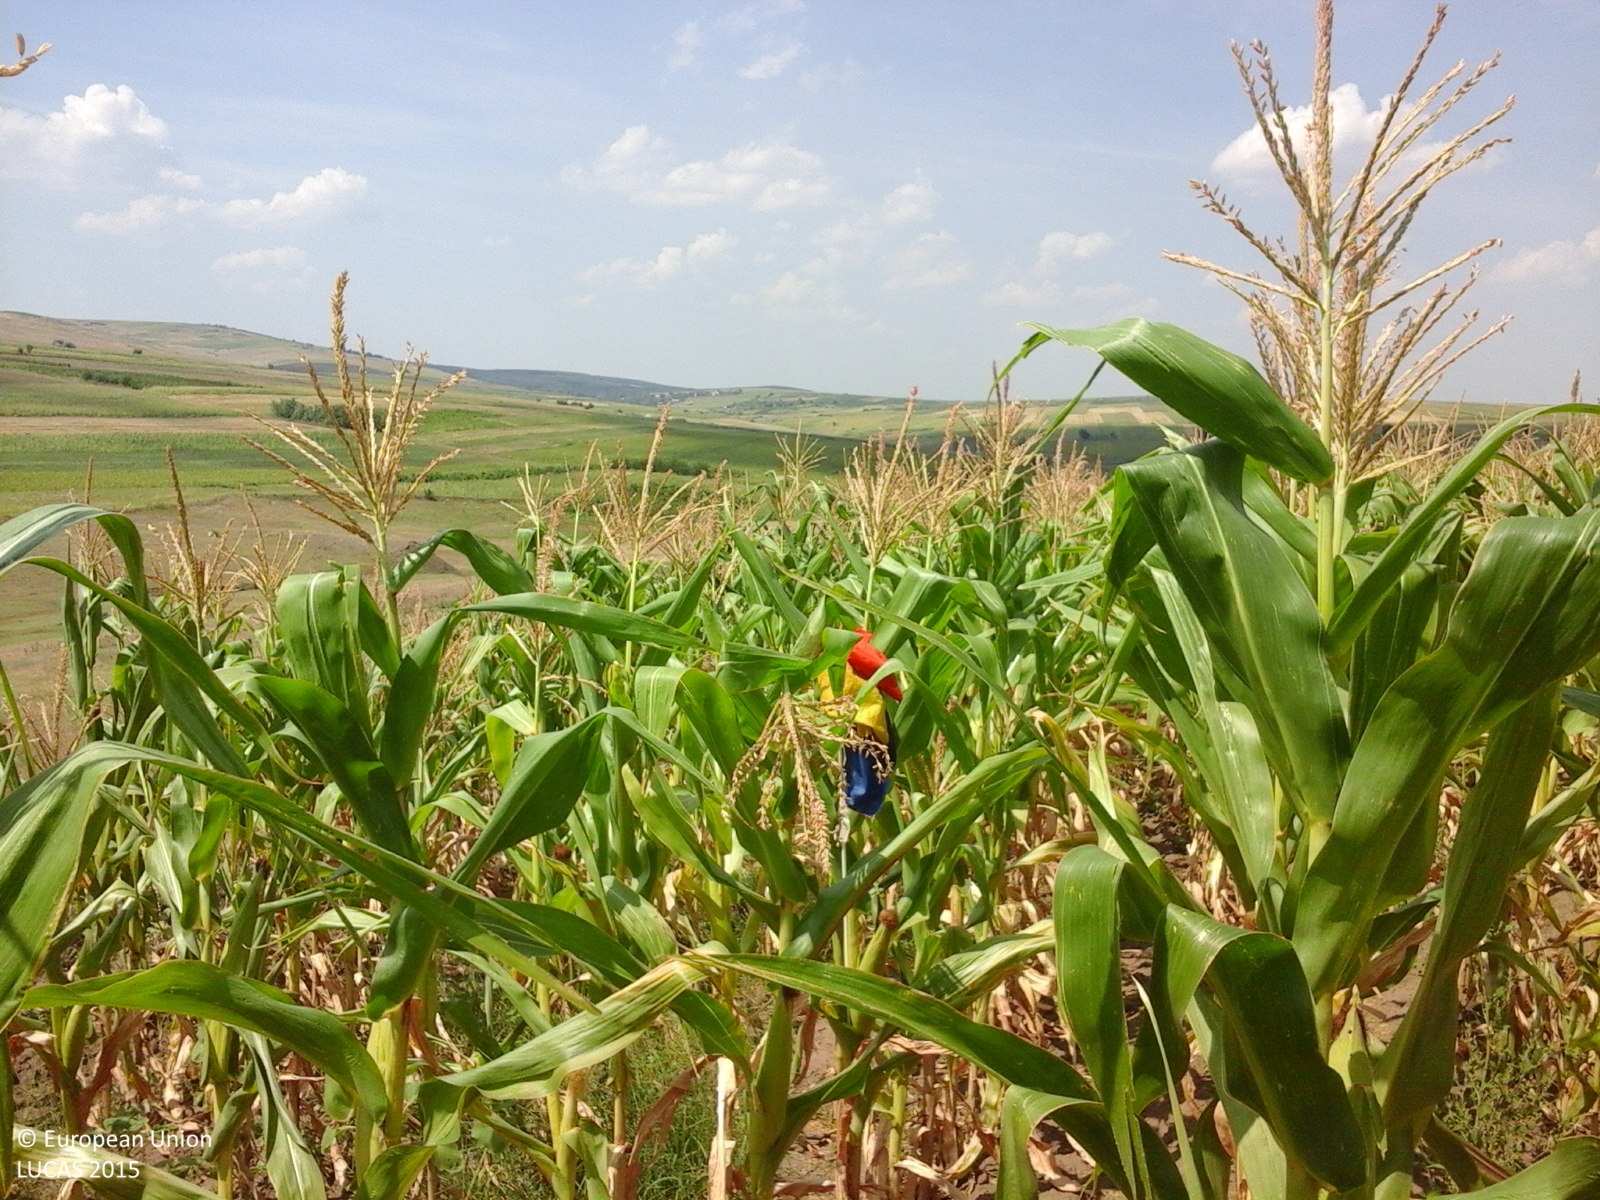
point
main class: Cropland
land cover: Maize
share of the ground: > 75 %
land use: Agriculture (excluding fallow land and kitchen gardens)
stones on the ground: < 10 %
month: July
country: RO
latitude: 46.5879
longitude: 28.1561
